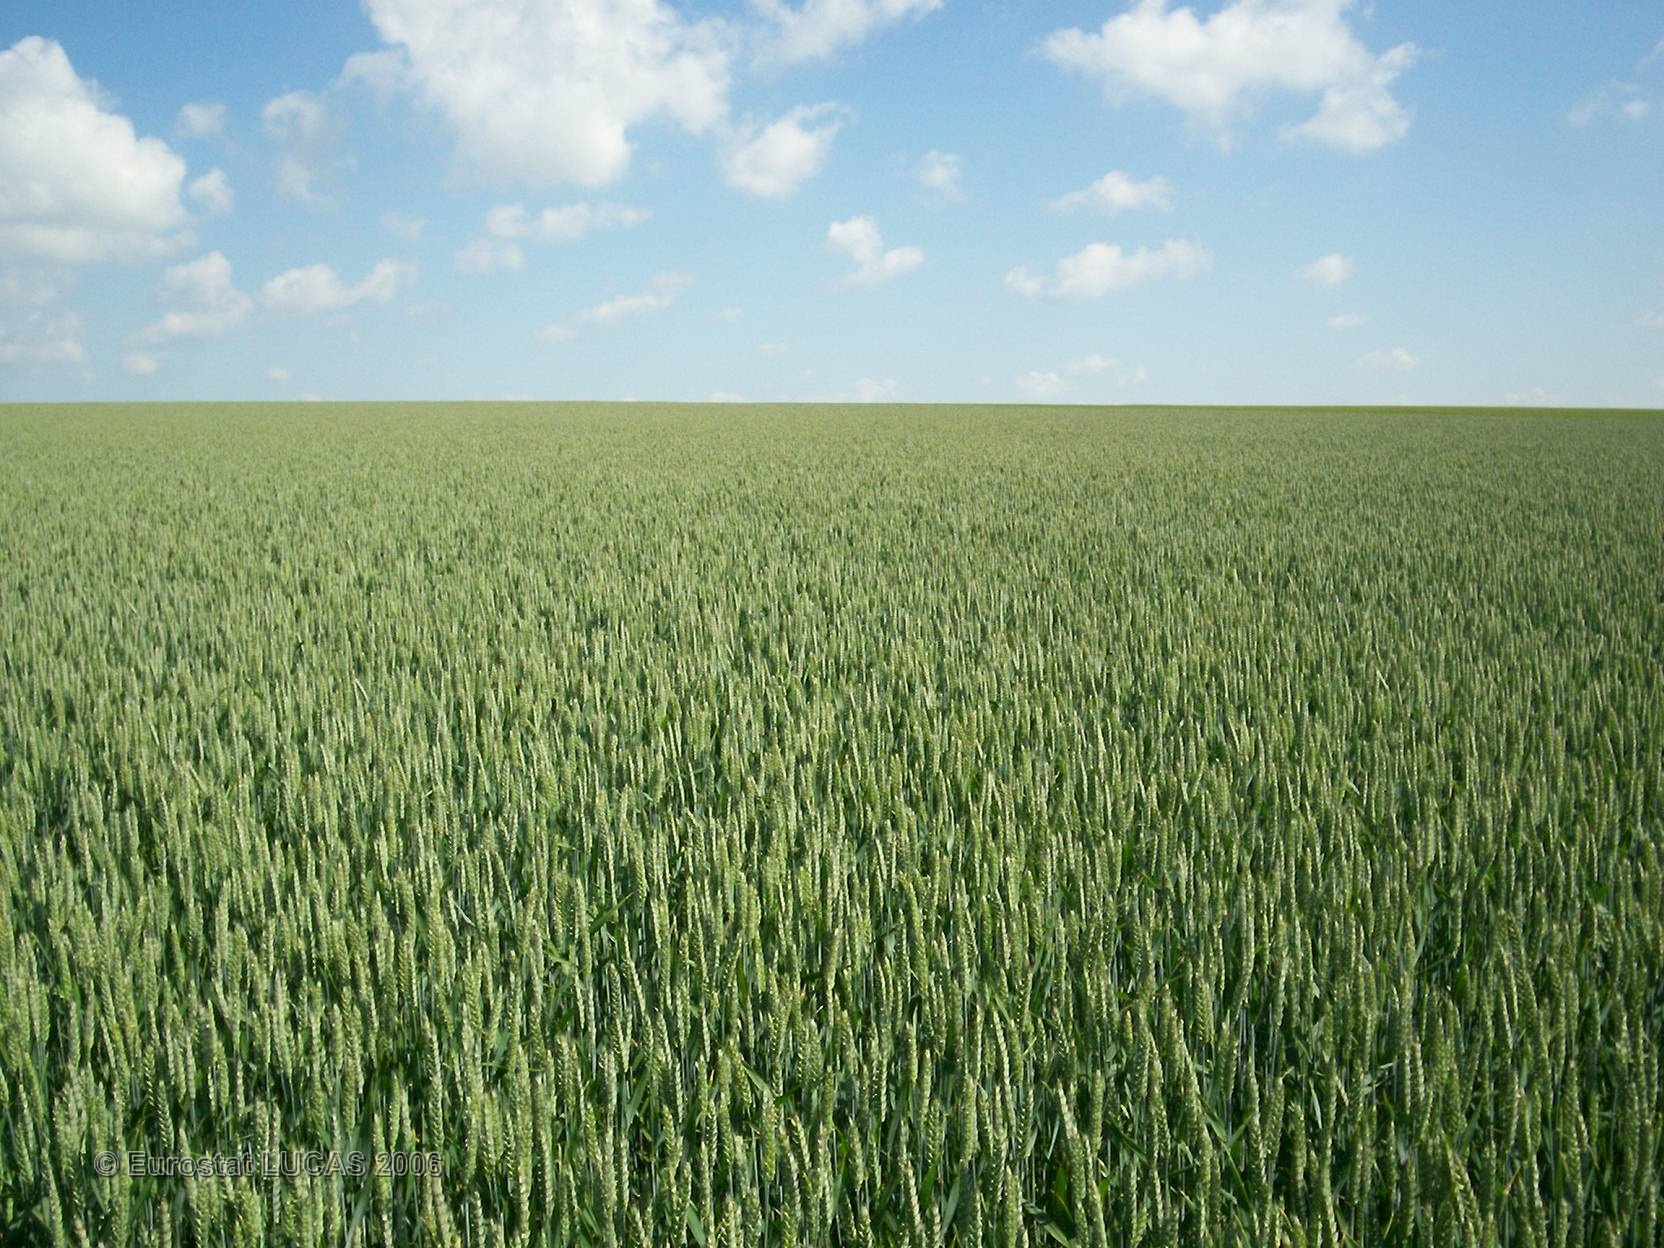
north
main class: Cropland
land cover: Common wheat
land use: Agriculture (excluding fallow land and kitchen gardens)
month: June
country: FR
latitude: 48.8206
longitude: 4.3988
